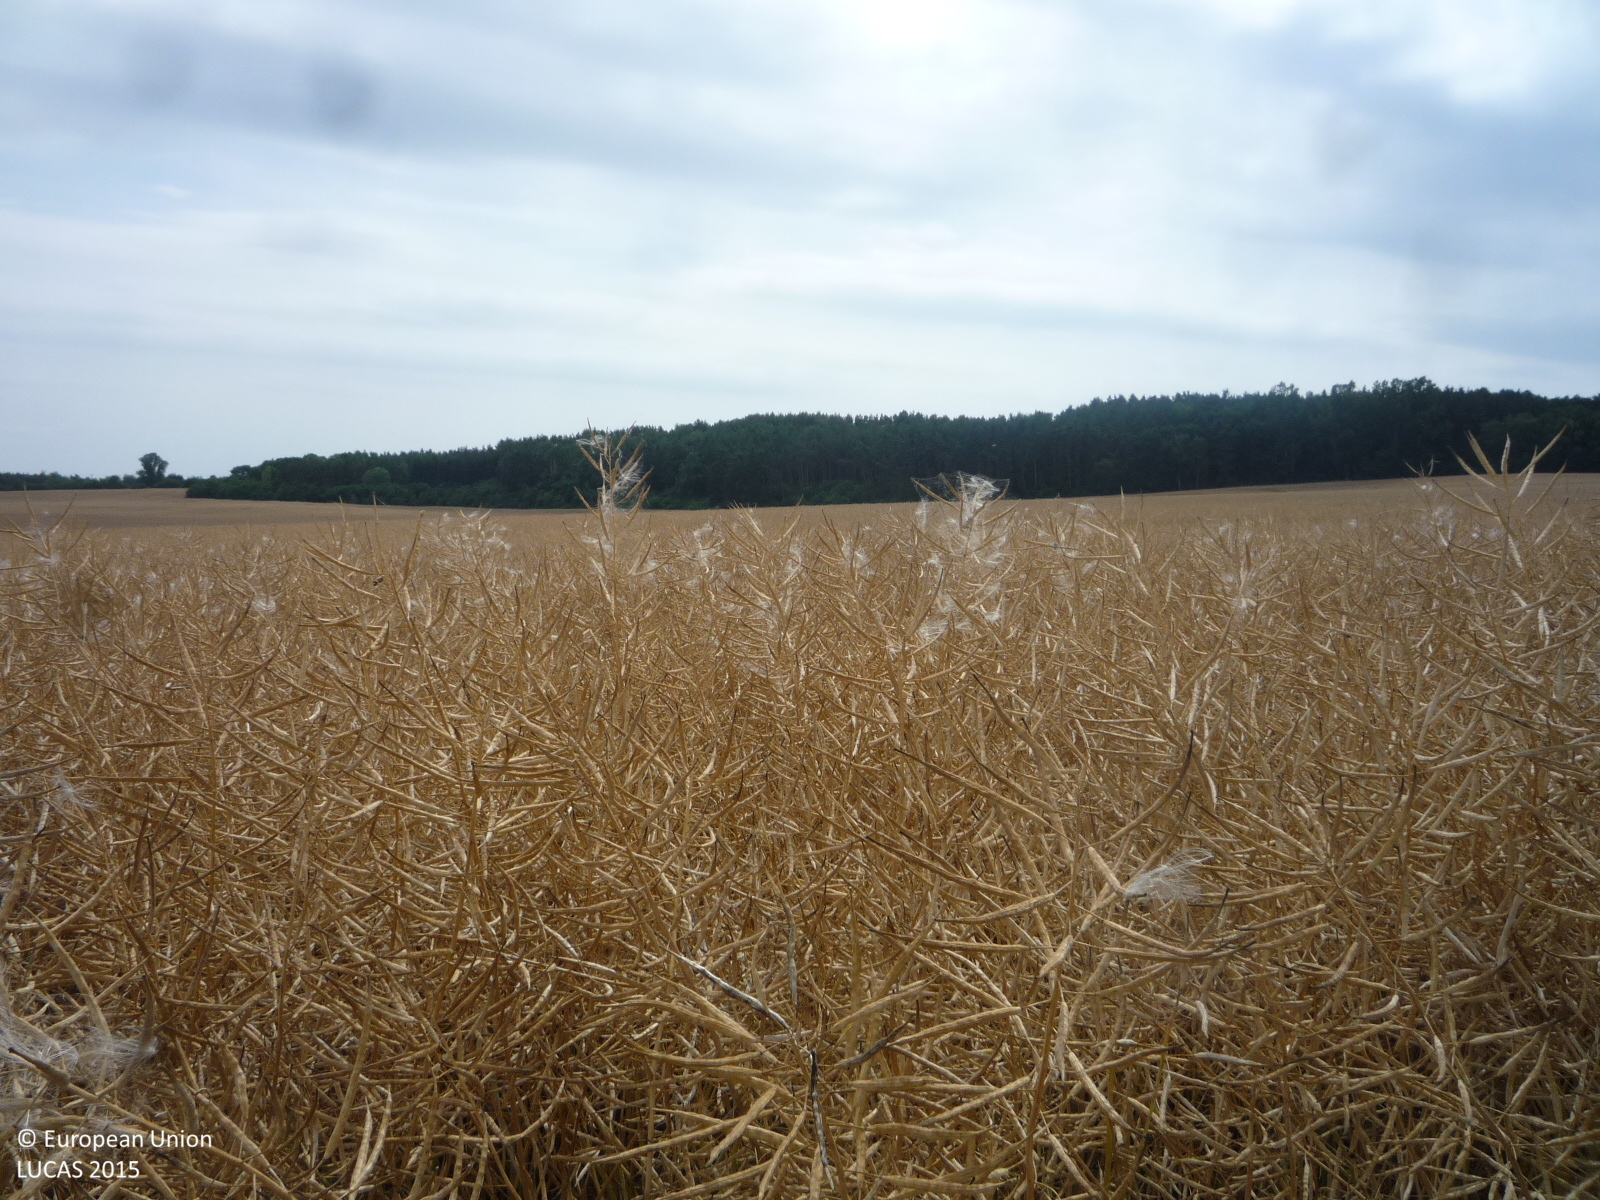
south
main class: Cropland
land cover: Rape and turnip rape
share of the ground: > 75 %
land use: Agriculture (excluding fallow land and kitchen gardens)
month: July
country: CZ
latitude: 50.2759
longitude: 14.9278
